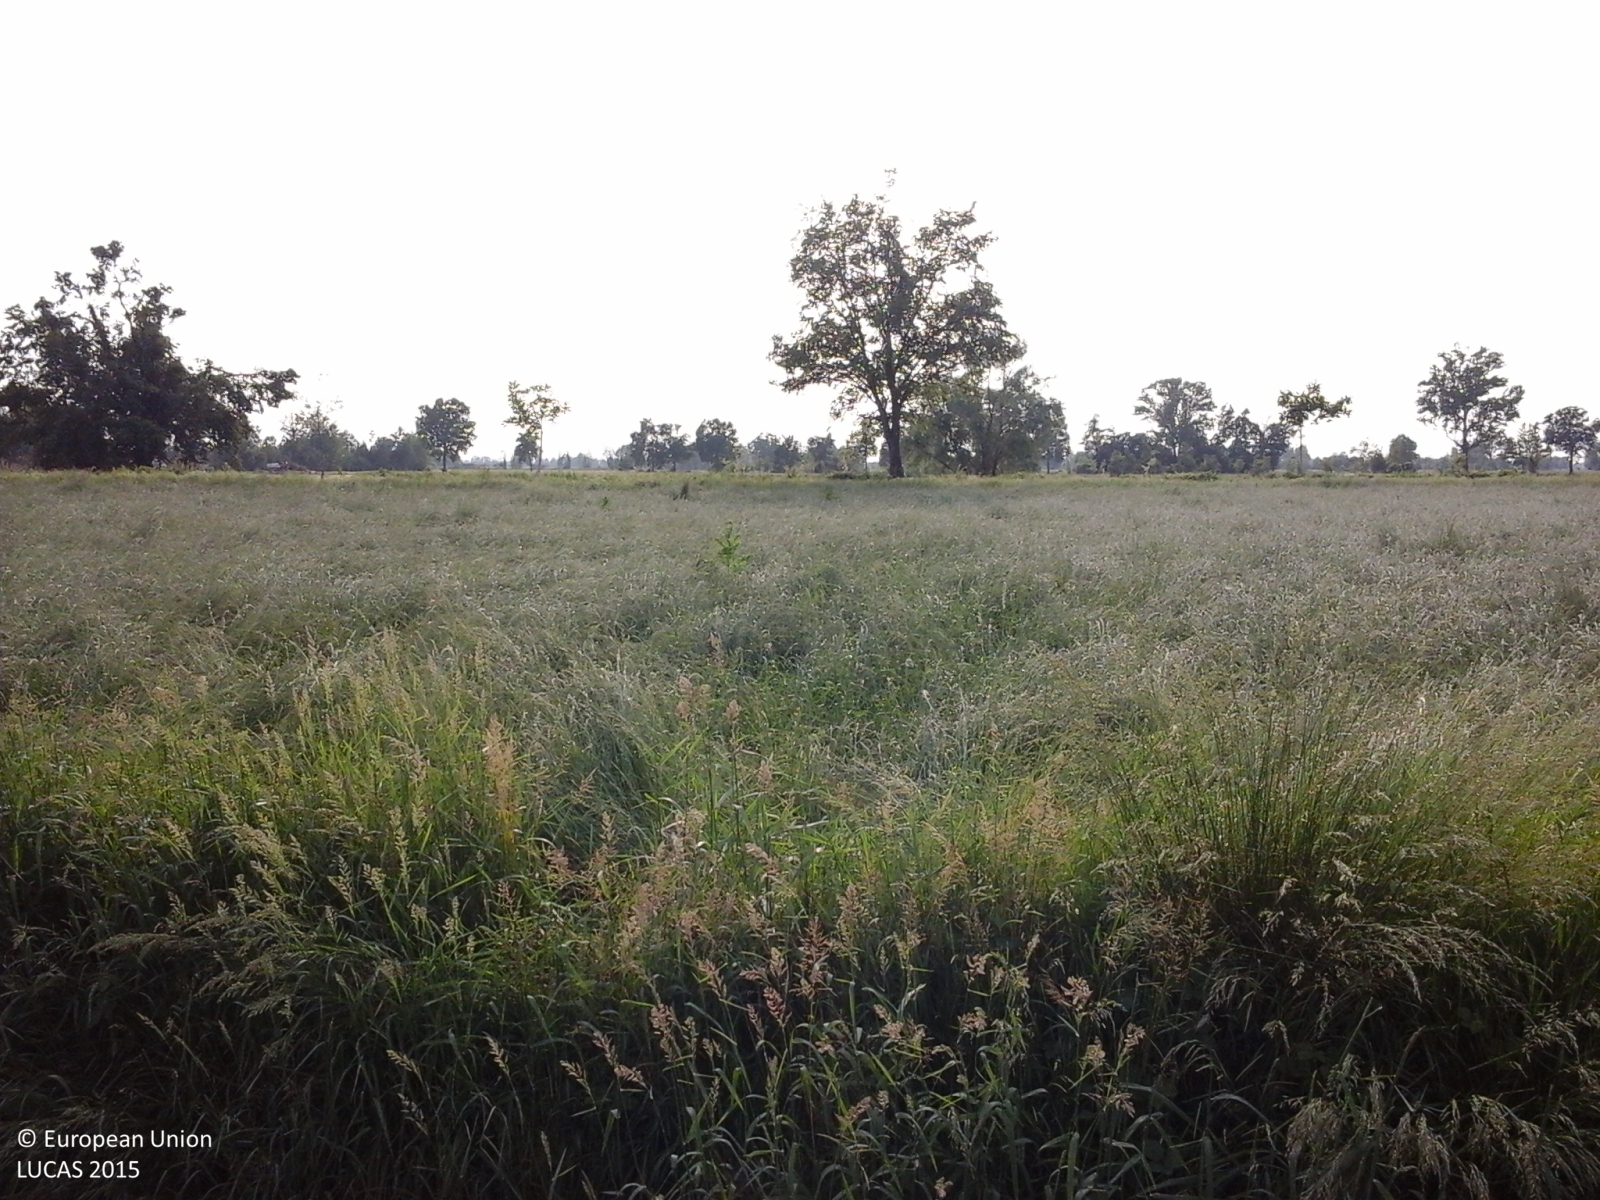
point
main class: Cropland
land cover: Temporary grasslands
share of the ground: > 75 %
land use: Agriculture (excluding fallow land and kitchen gardens)
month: May
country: IT
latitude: 45.2160
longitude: 10.0127
